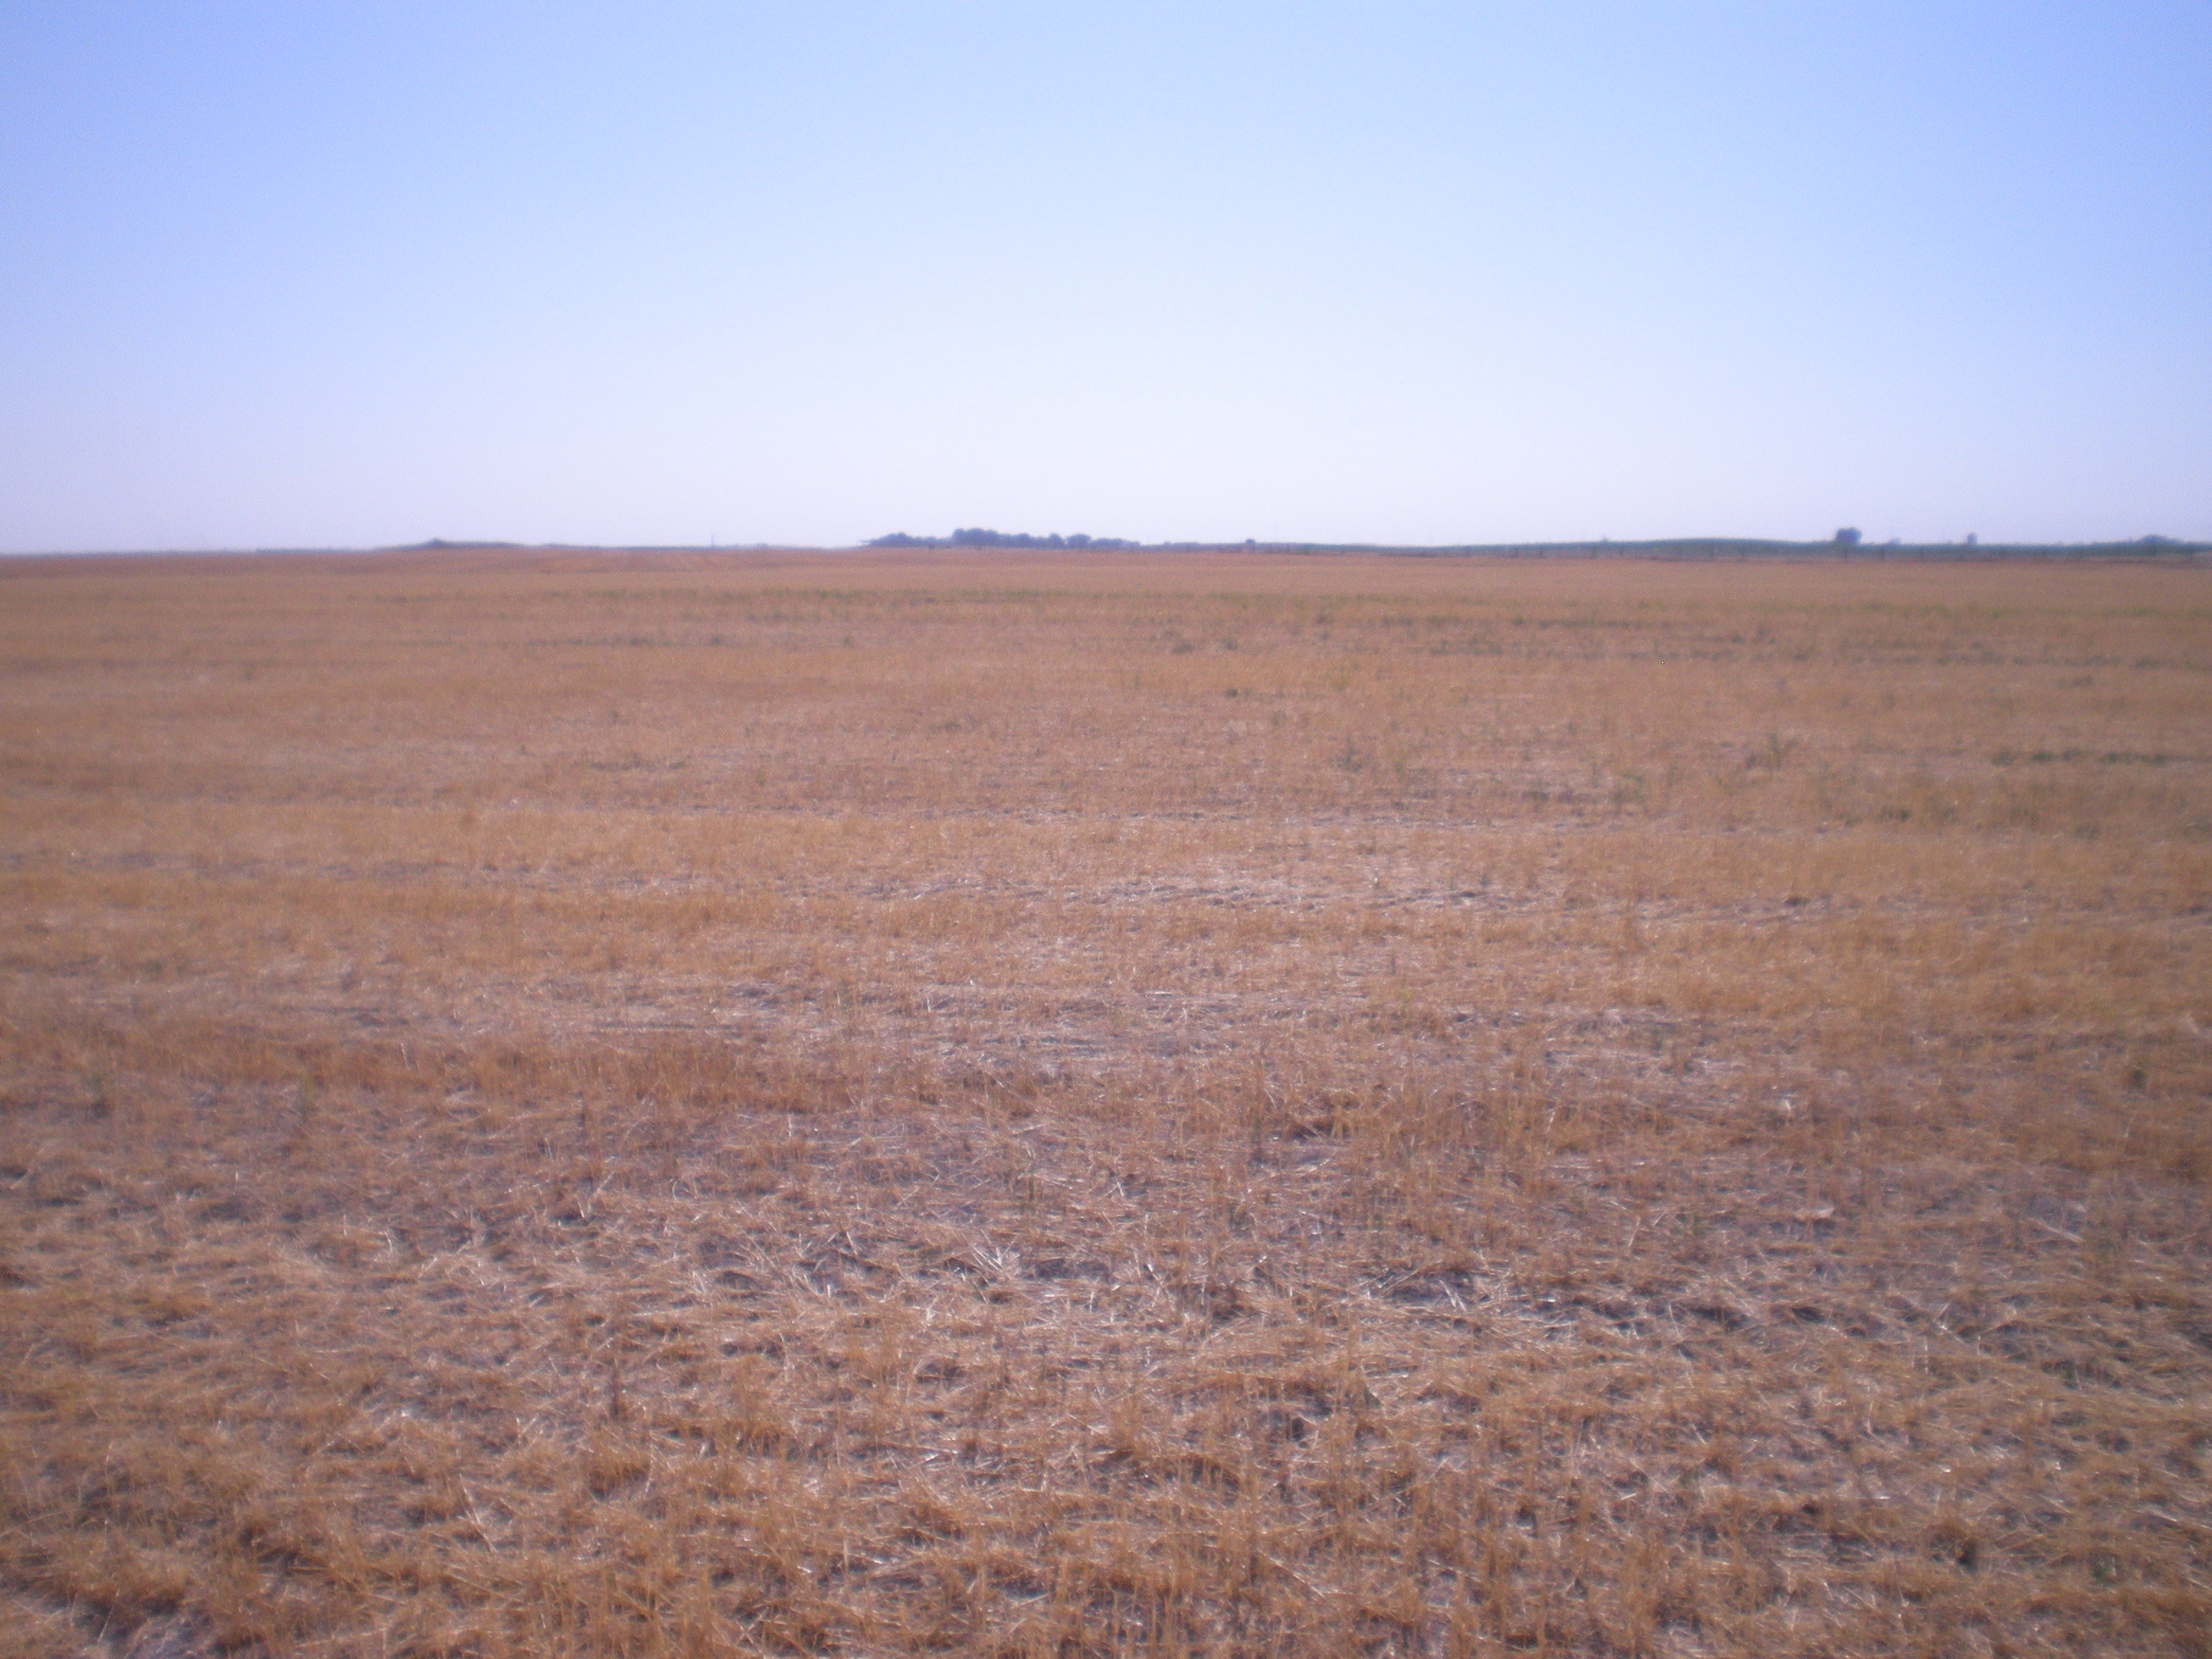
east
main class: Cropland
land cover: Barley
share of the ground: < 10 %
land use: Agriculture (excluding fallow land and kitchen gardens)
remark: Harvested field
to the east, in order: Barley; Grass margins; Tracks; Grass margins; Oats
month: July
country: ES
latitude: 39.2884
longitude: -3.2689
